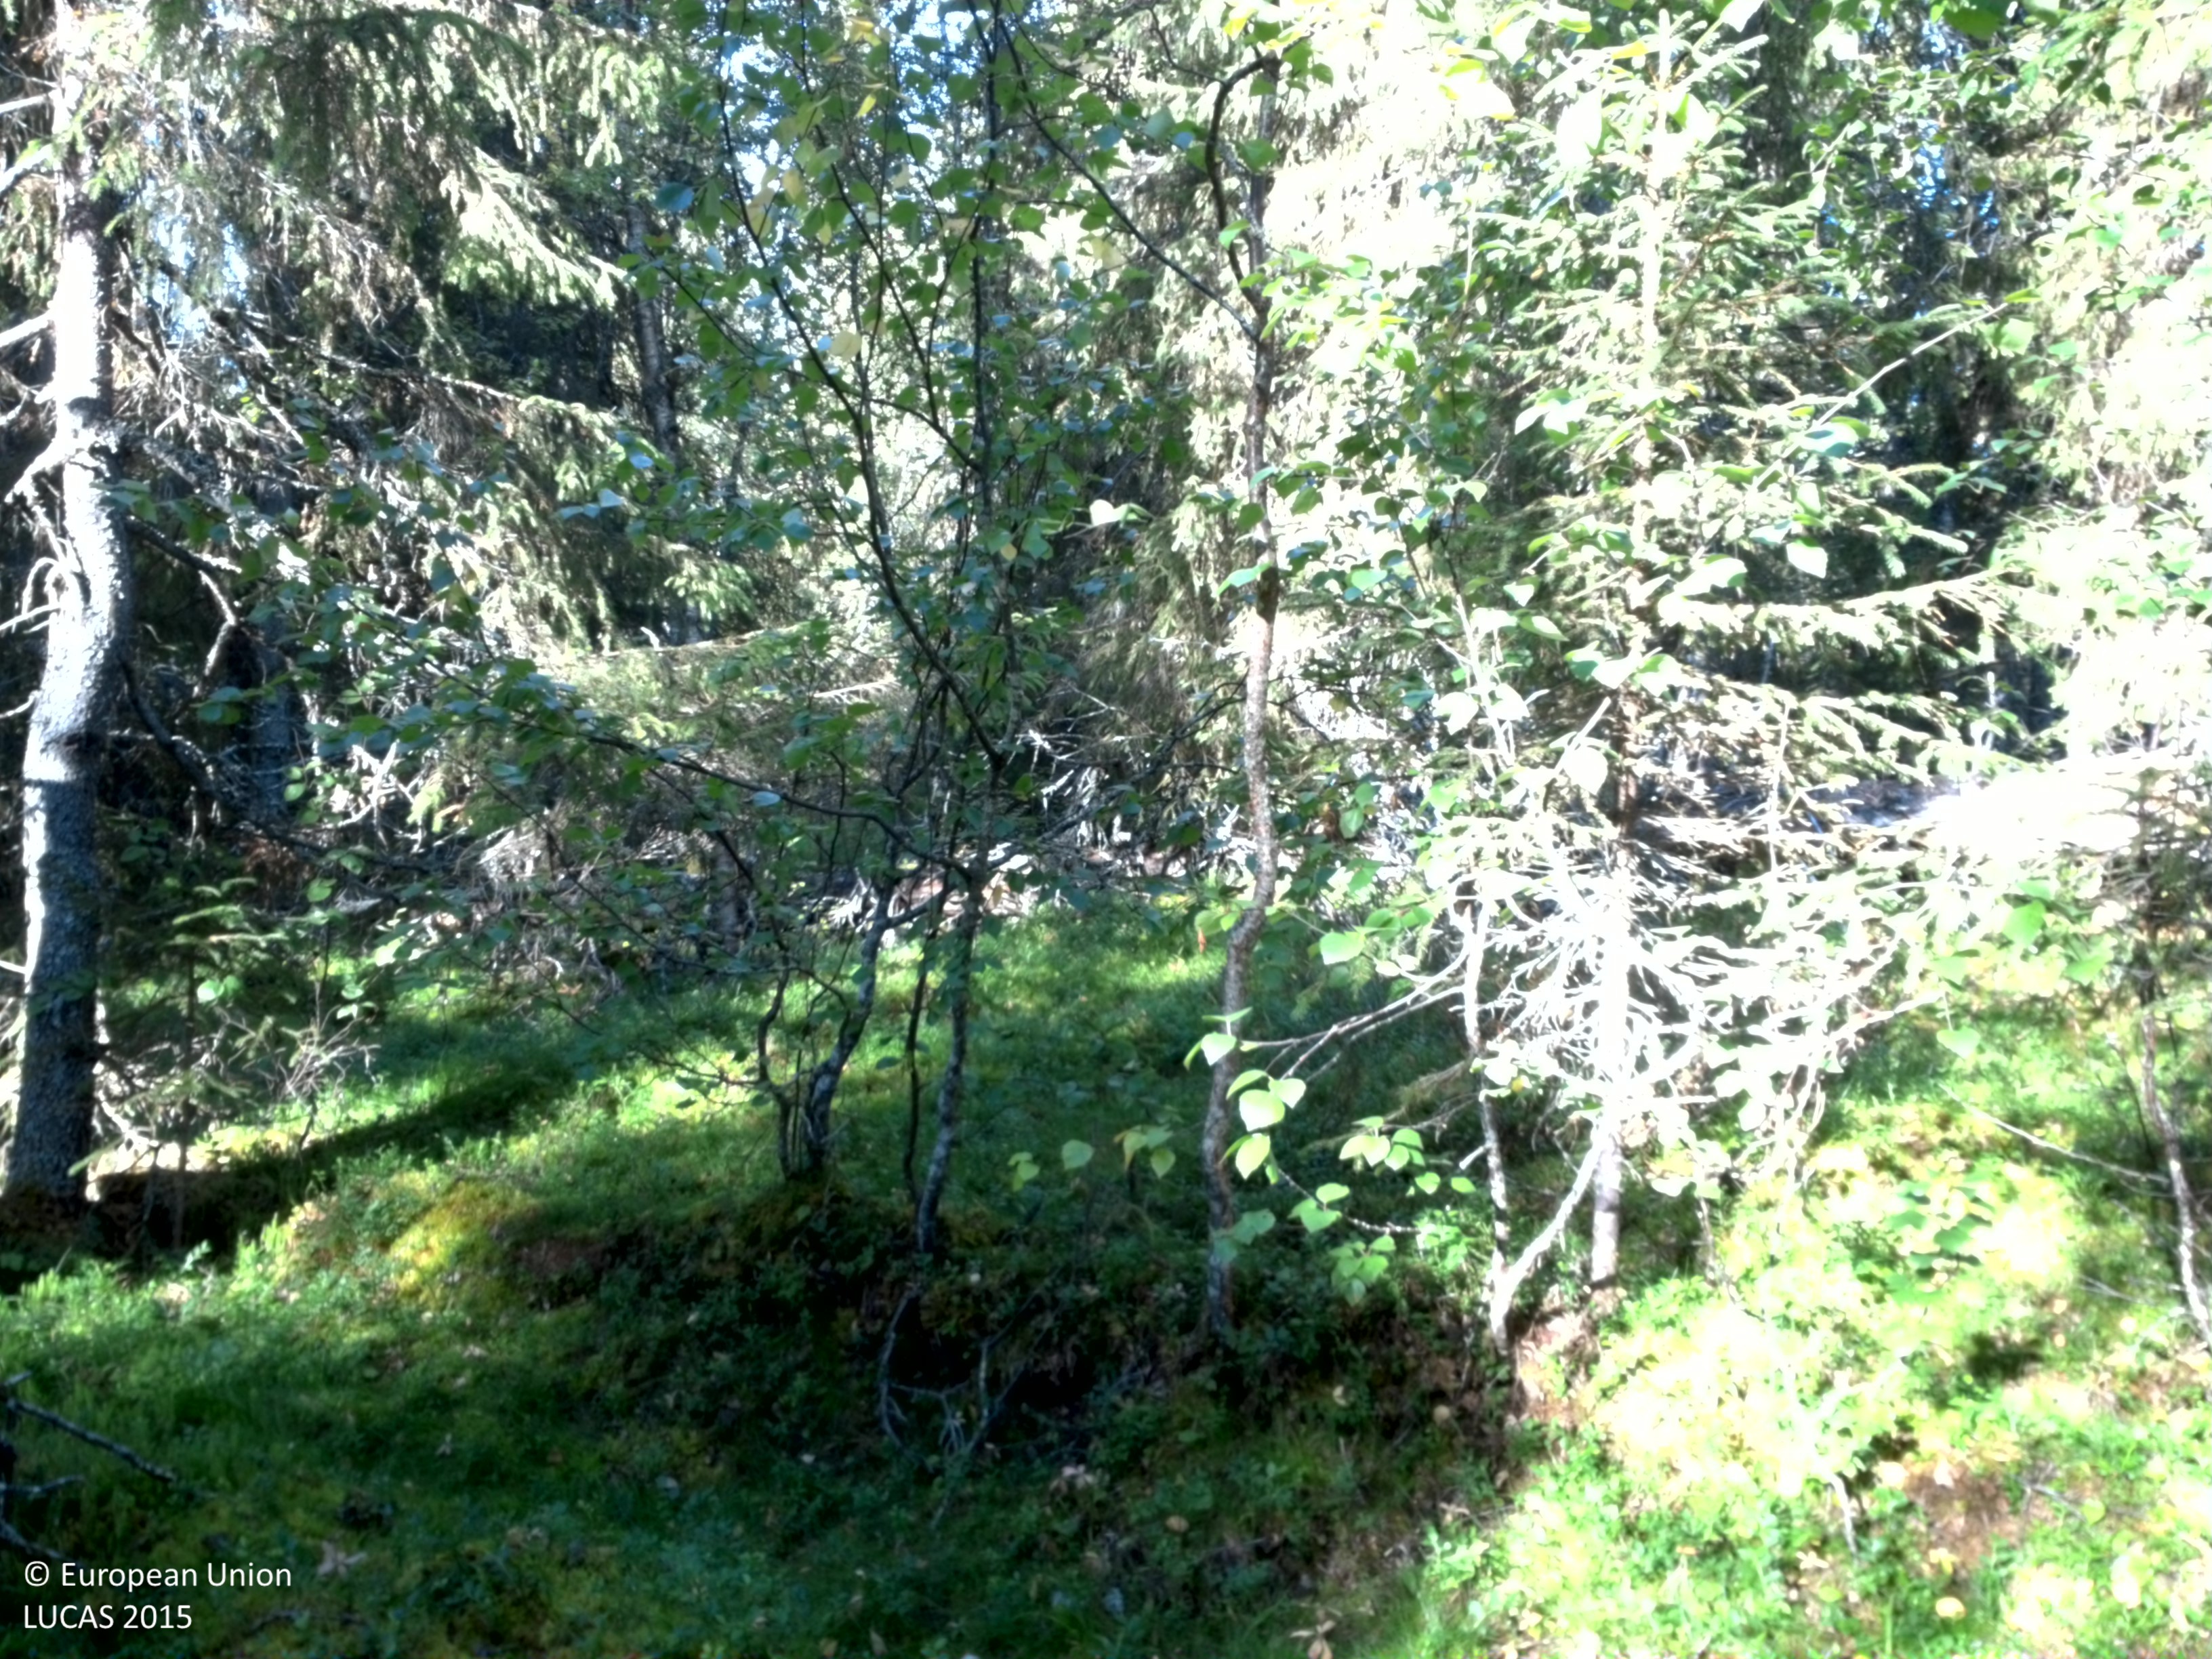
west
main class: Woodland
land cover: Spruce dominated coniferous woodland
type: boreal forest
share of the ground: 25 - 50 %
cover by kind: coniferous forest trees 30 %, shrubs 25 %, herbaceous plants 25 %, lichens and mosses 15 %, broadleaved forest trees 5 %
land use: Amenities, museums, leisure
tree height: > 5 m
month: August
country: SE
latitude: 64.9845
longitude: 16.6408
